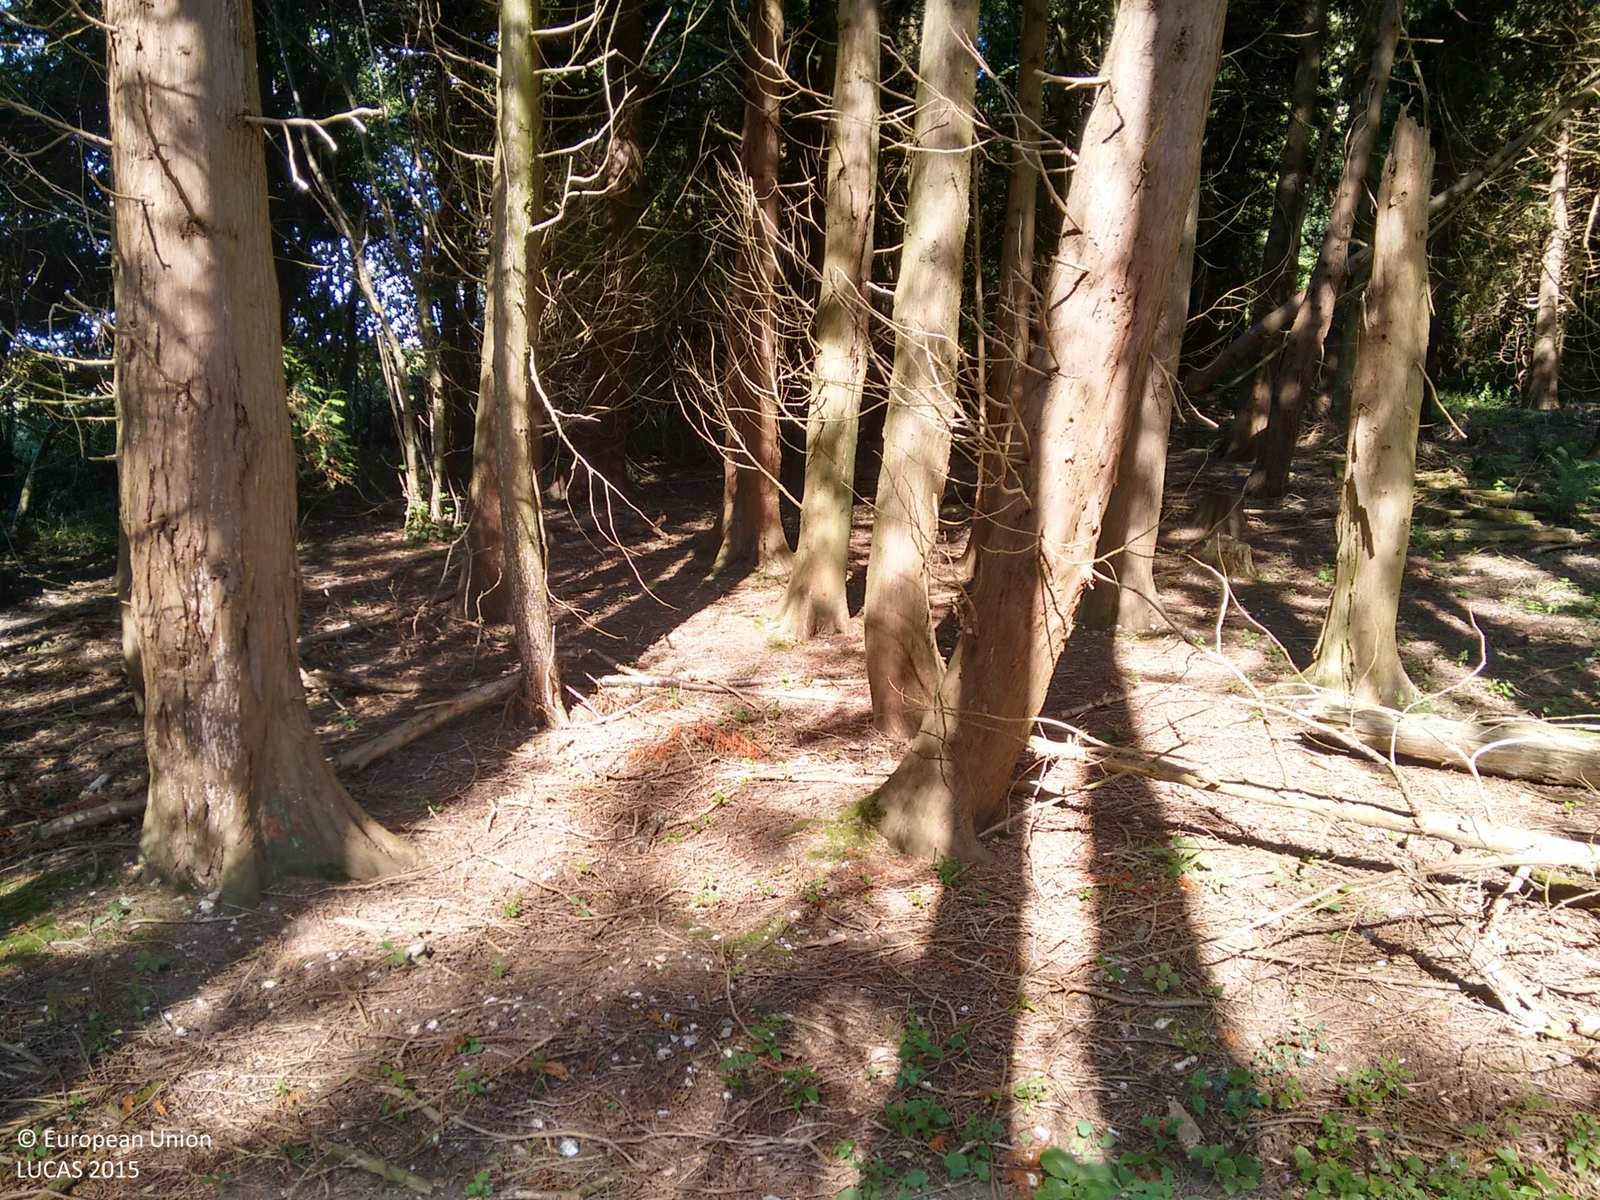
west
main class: Woodland
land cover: Other coniferous woodland
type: exotic forest
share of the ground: > 75 %
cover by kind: coniferous forest trees 100 %
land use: Forestry
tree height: > 5 m
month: July
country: GB
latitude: 50.9481
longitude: -0.9035
